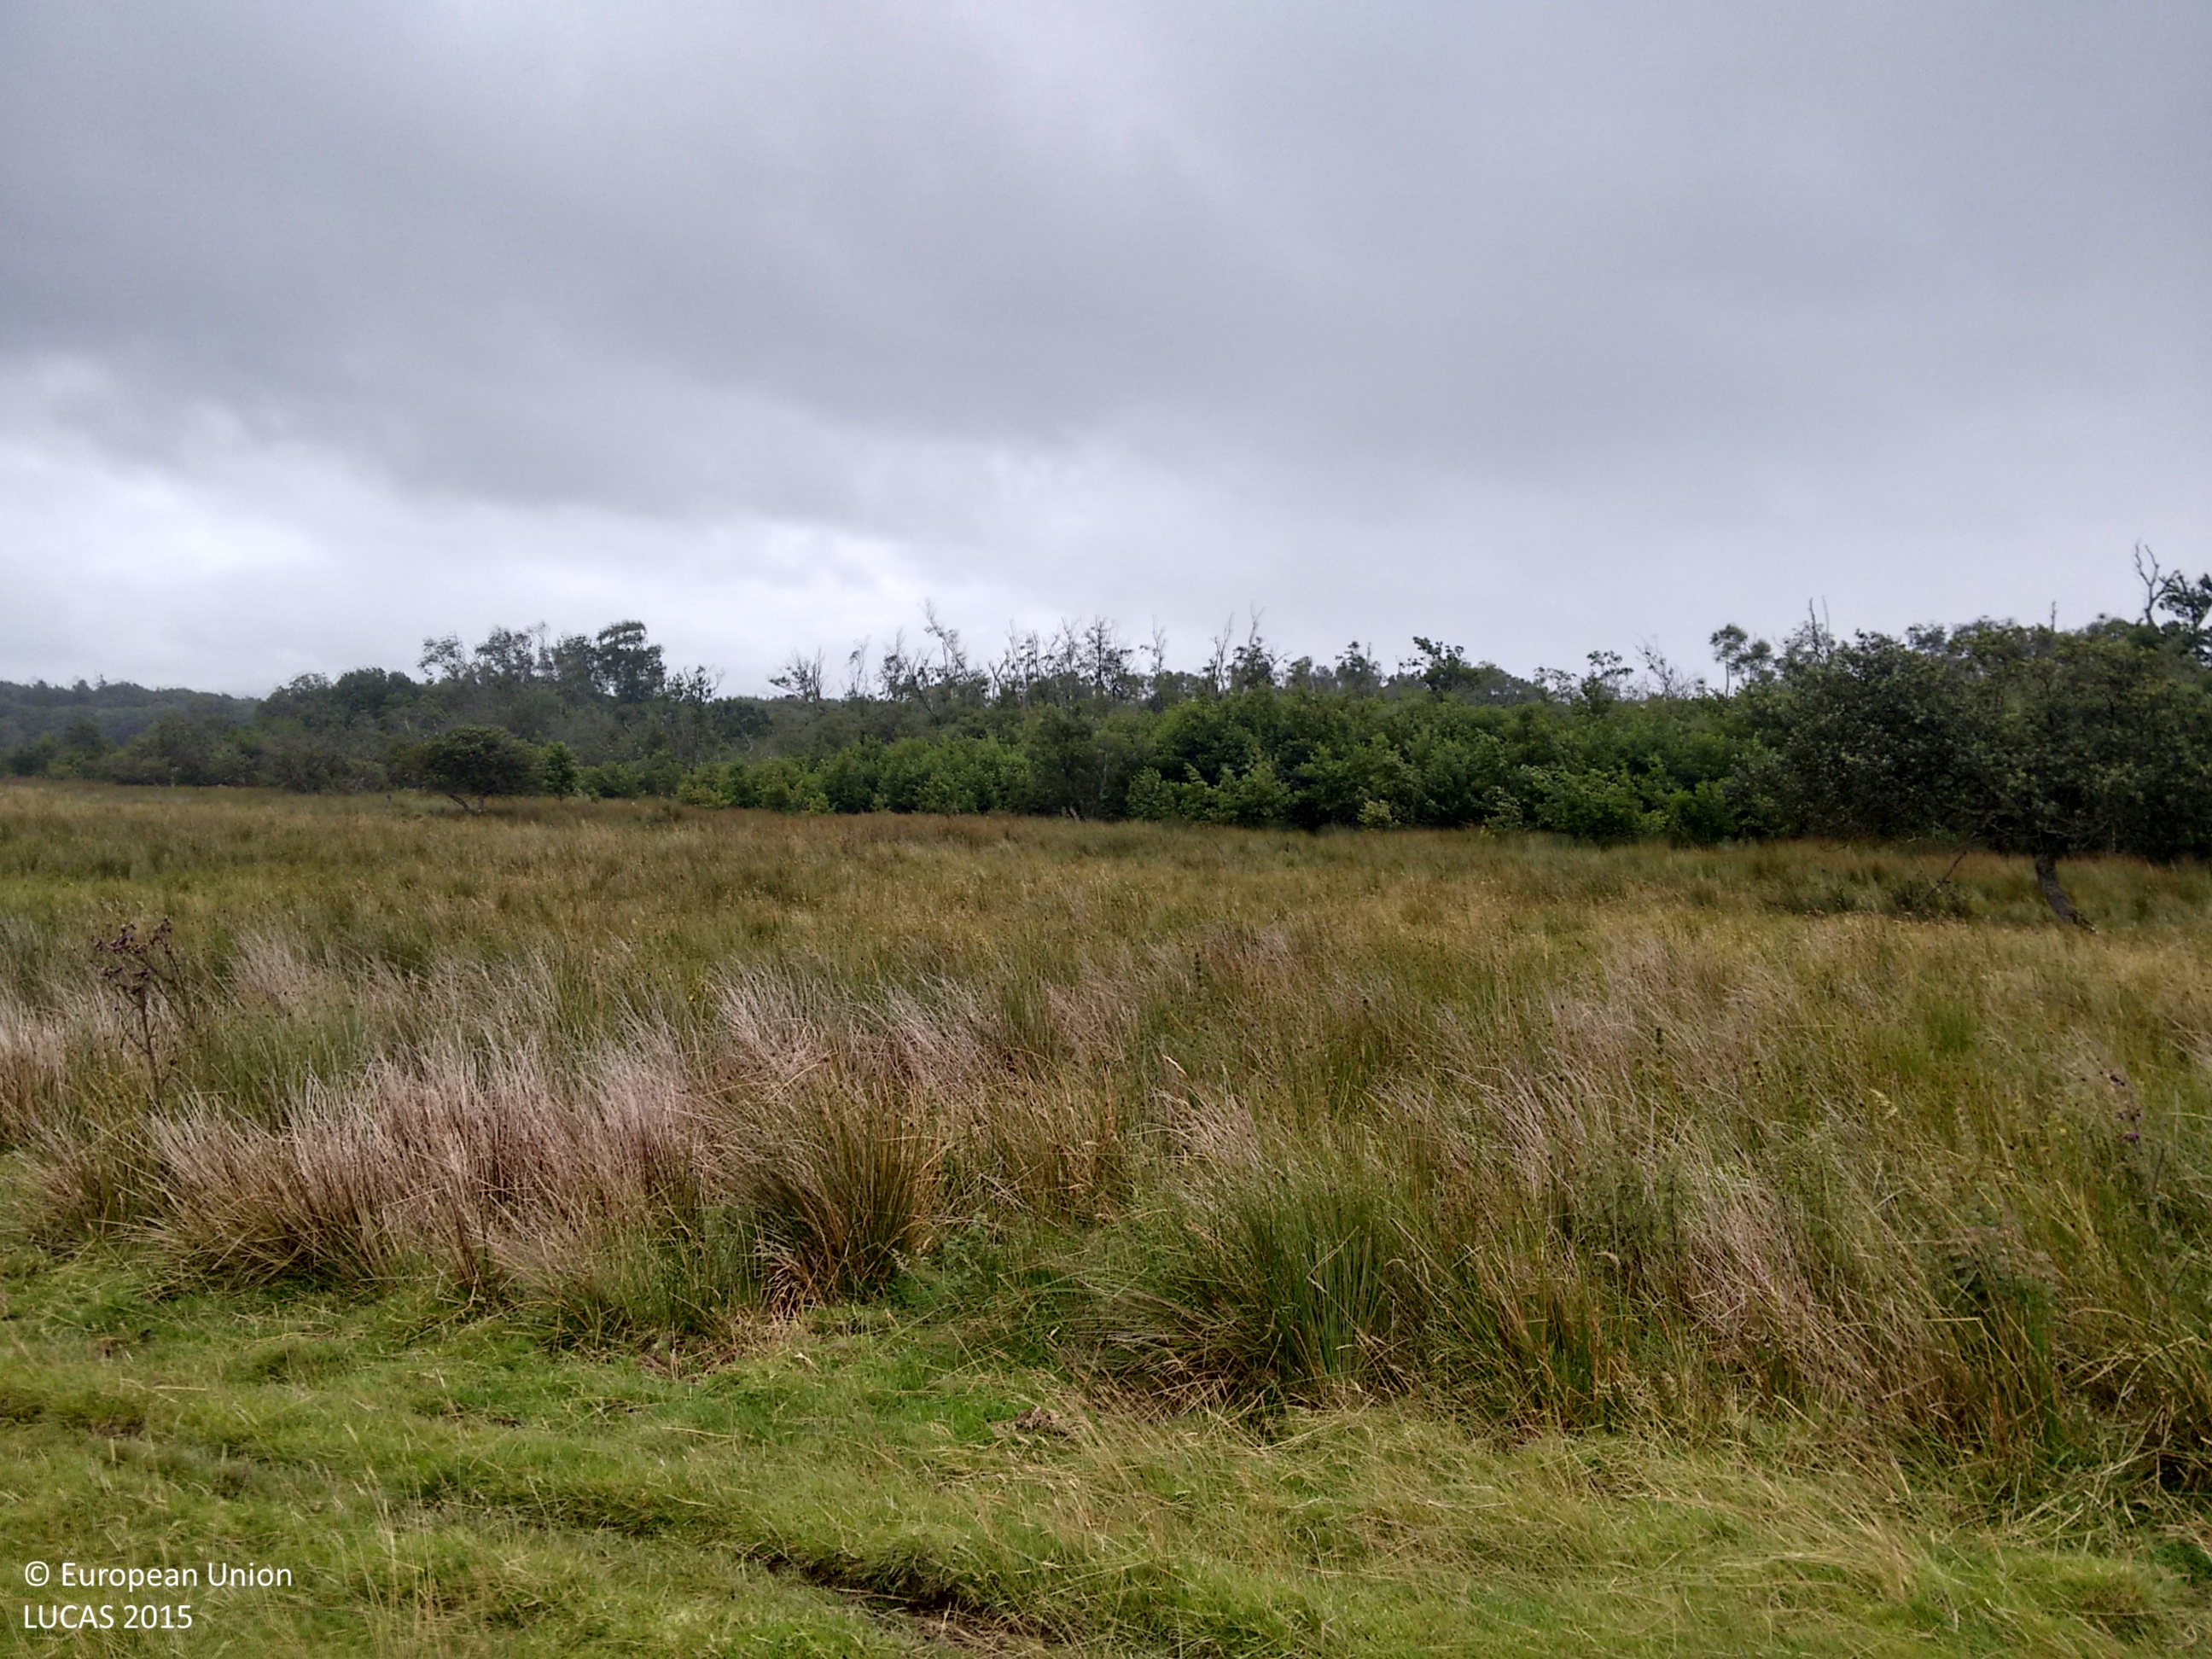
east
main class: Grassland
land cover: Grassland without tree/shrub cover
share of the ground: > 75 %
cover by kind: herbaceous plants 100 %
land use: Agriculture (excluding fallow land and kitchen gardens)
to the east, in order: Grassland without tree/shrub cover; Inland marshes; Broadleaved woodland
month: August
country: GB
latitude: 53.2146
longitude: -4.2202
